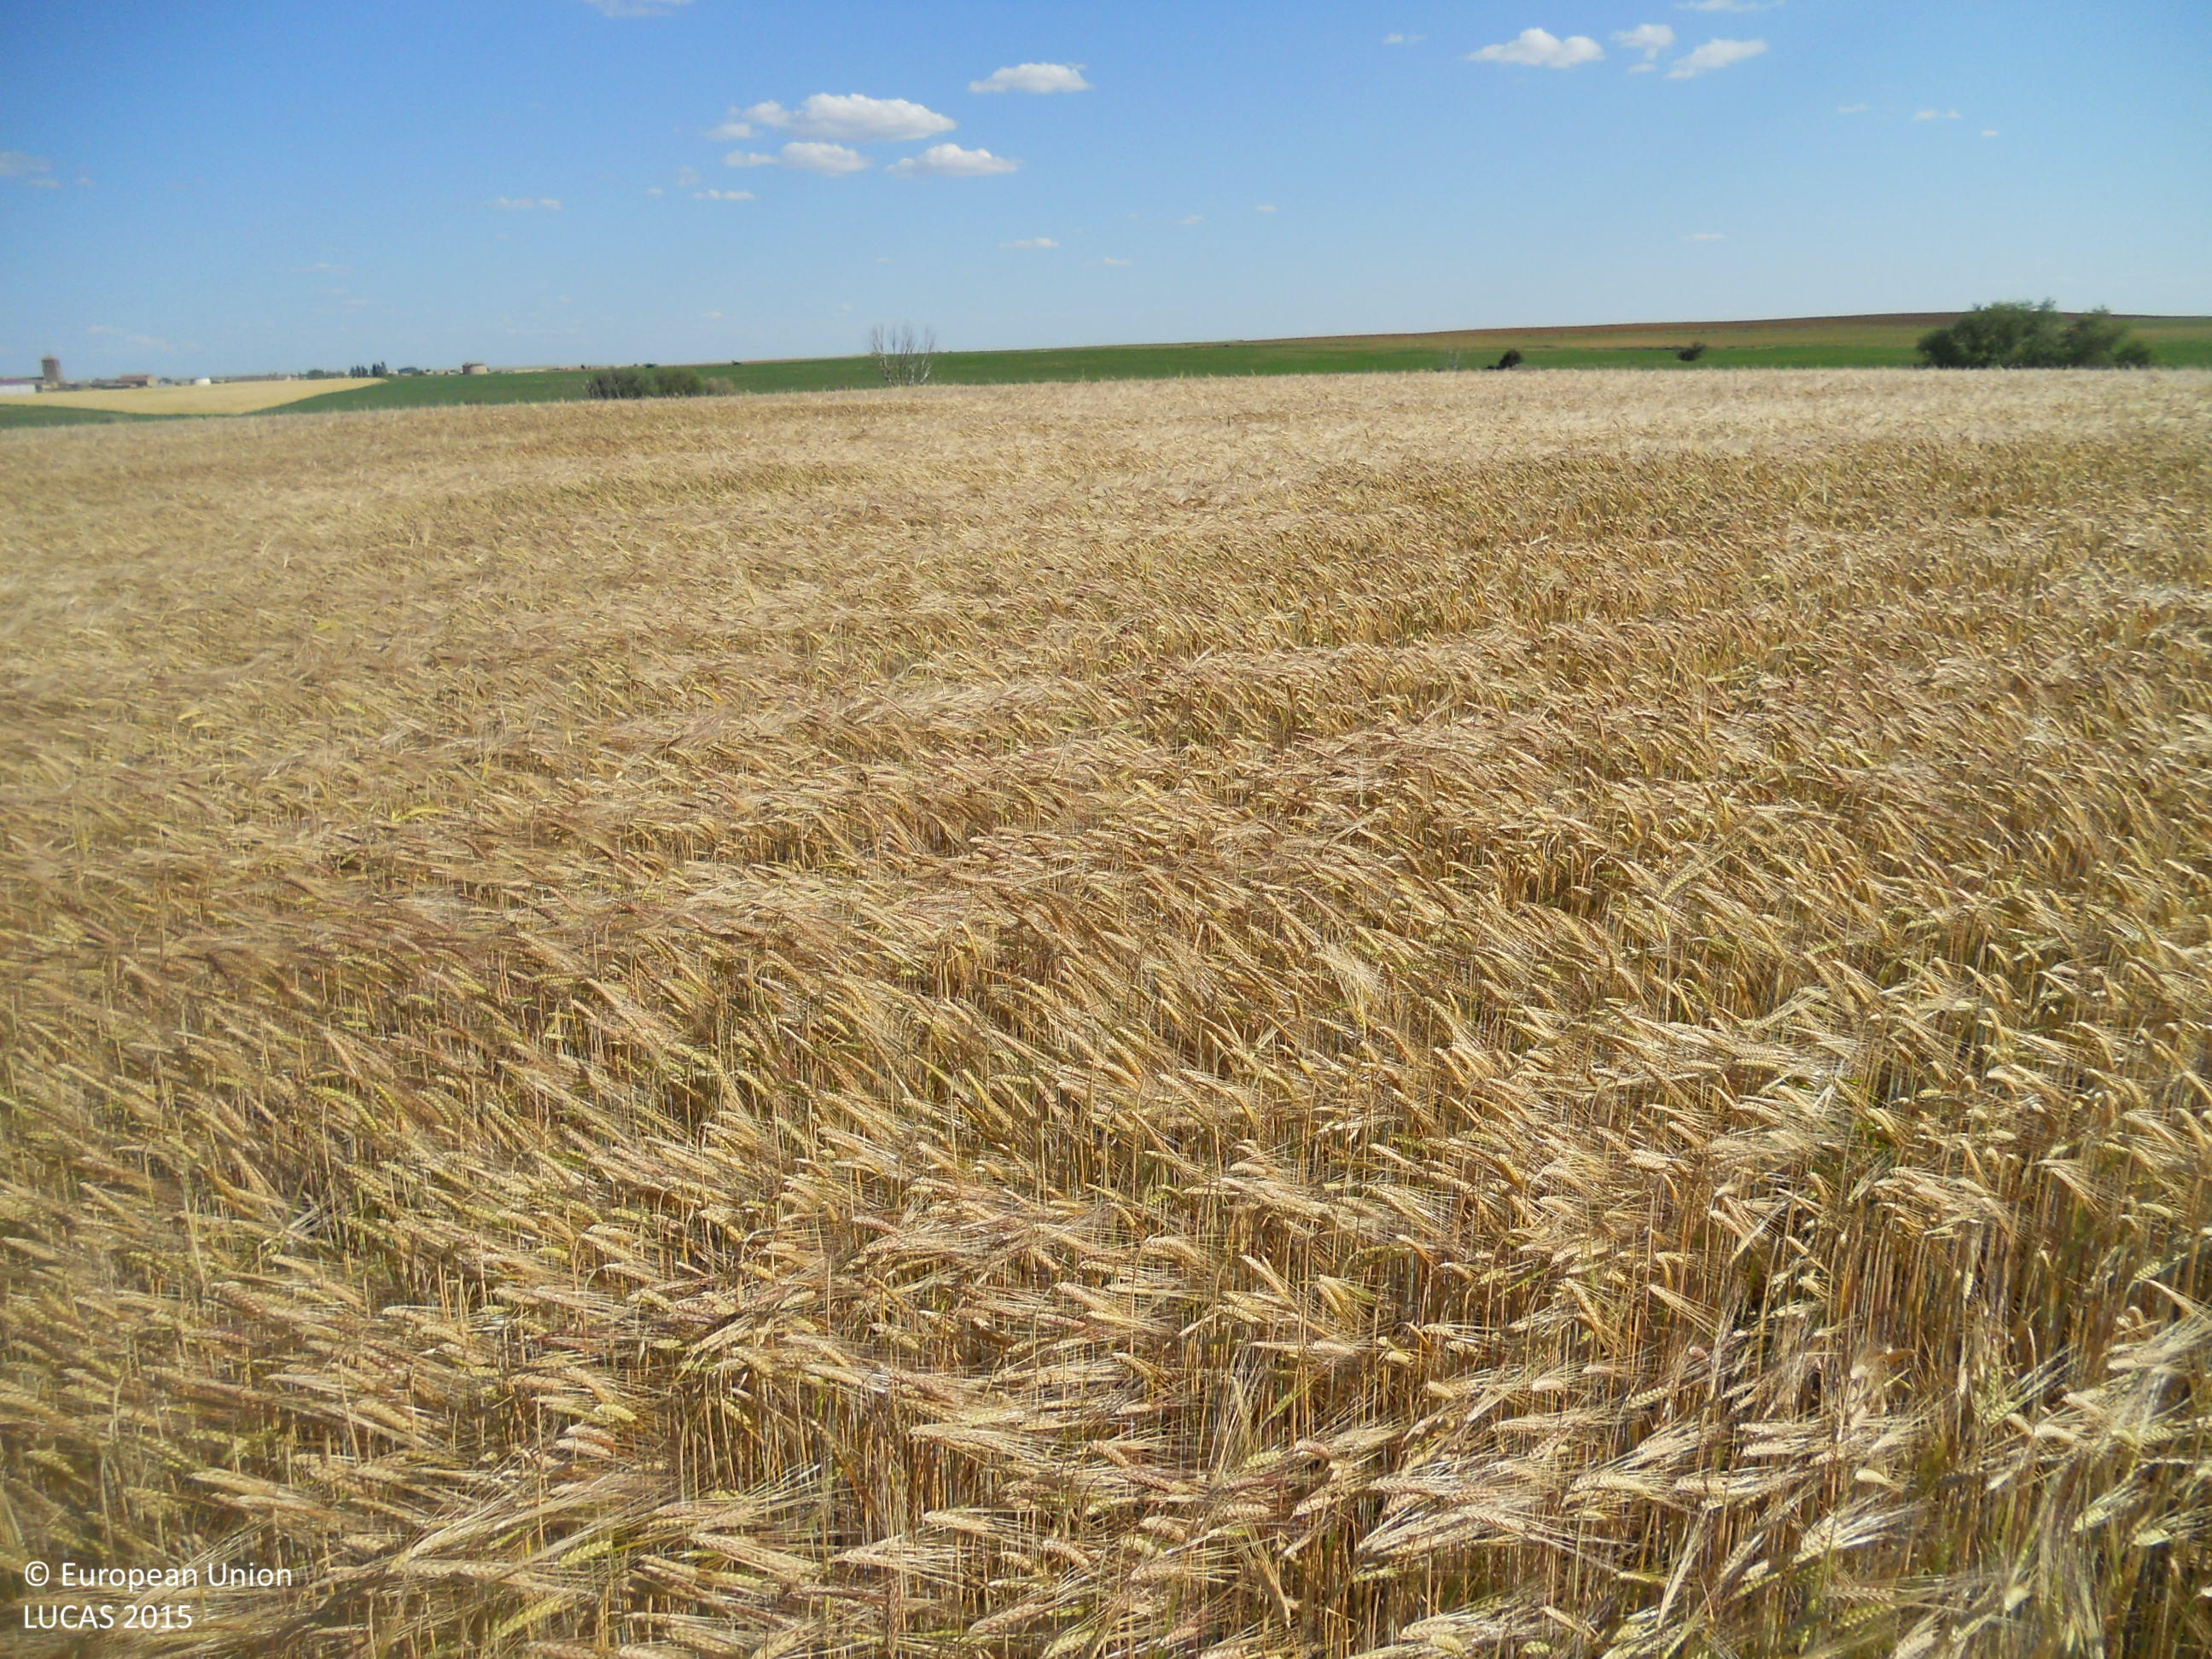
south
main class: Cropland
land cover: Barley
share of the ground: > 75 %
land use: Agriculture (excluding fallow land and kitchen gardens)
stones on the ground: < 10 %
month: May
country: ES
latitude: 42.3015
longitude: -4.8664
